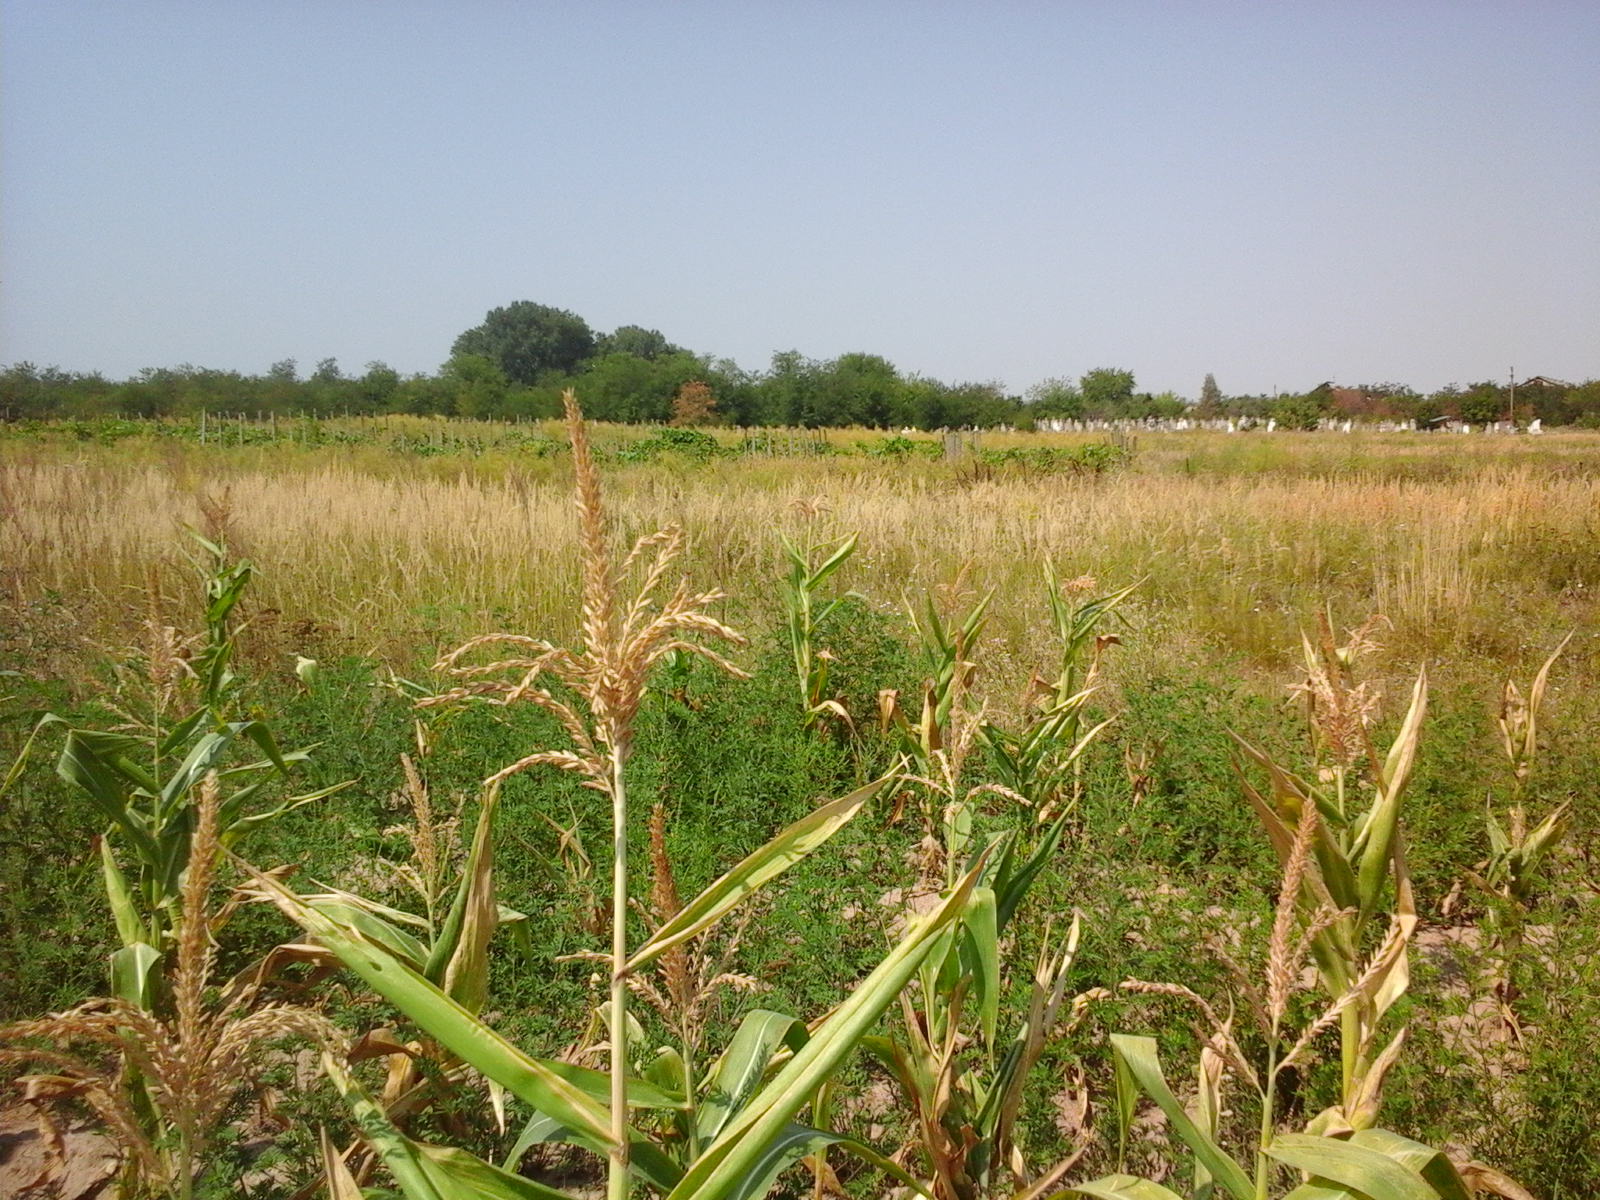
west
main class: Cropland
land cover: Maize
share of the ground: > 75 %
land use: Agriculture (excluding fallow land and kitchen gardens)
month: August
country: RO
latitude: 44.4075
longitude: 22.6852
